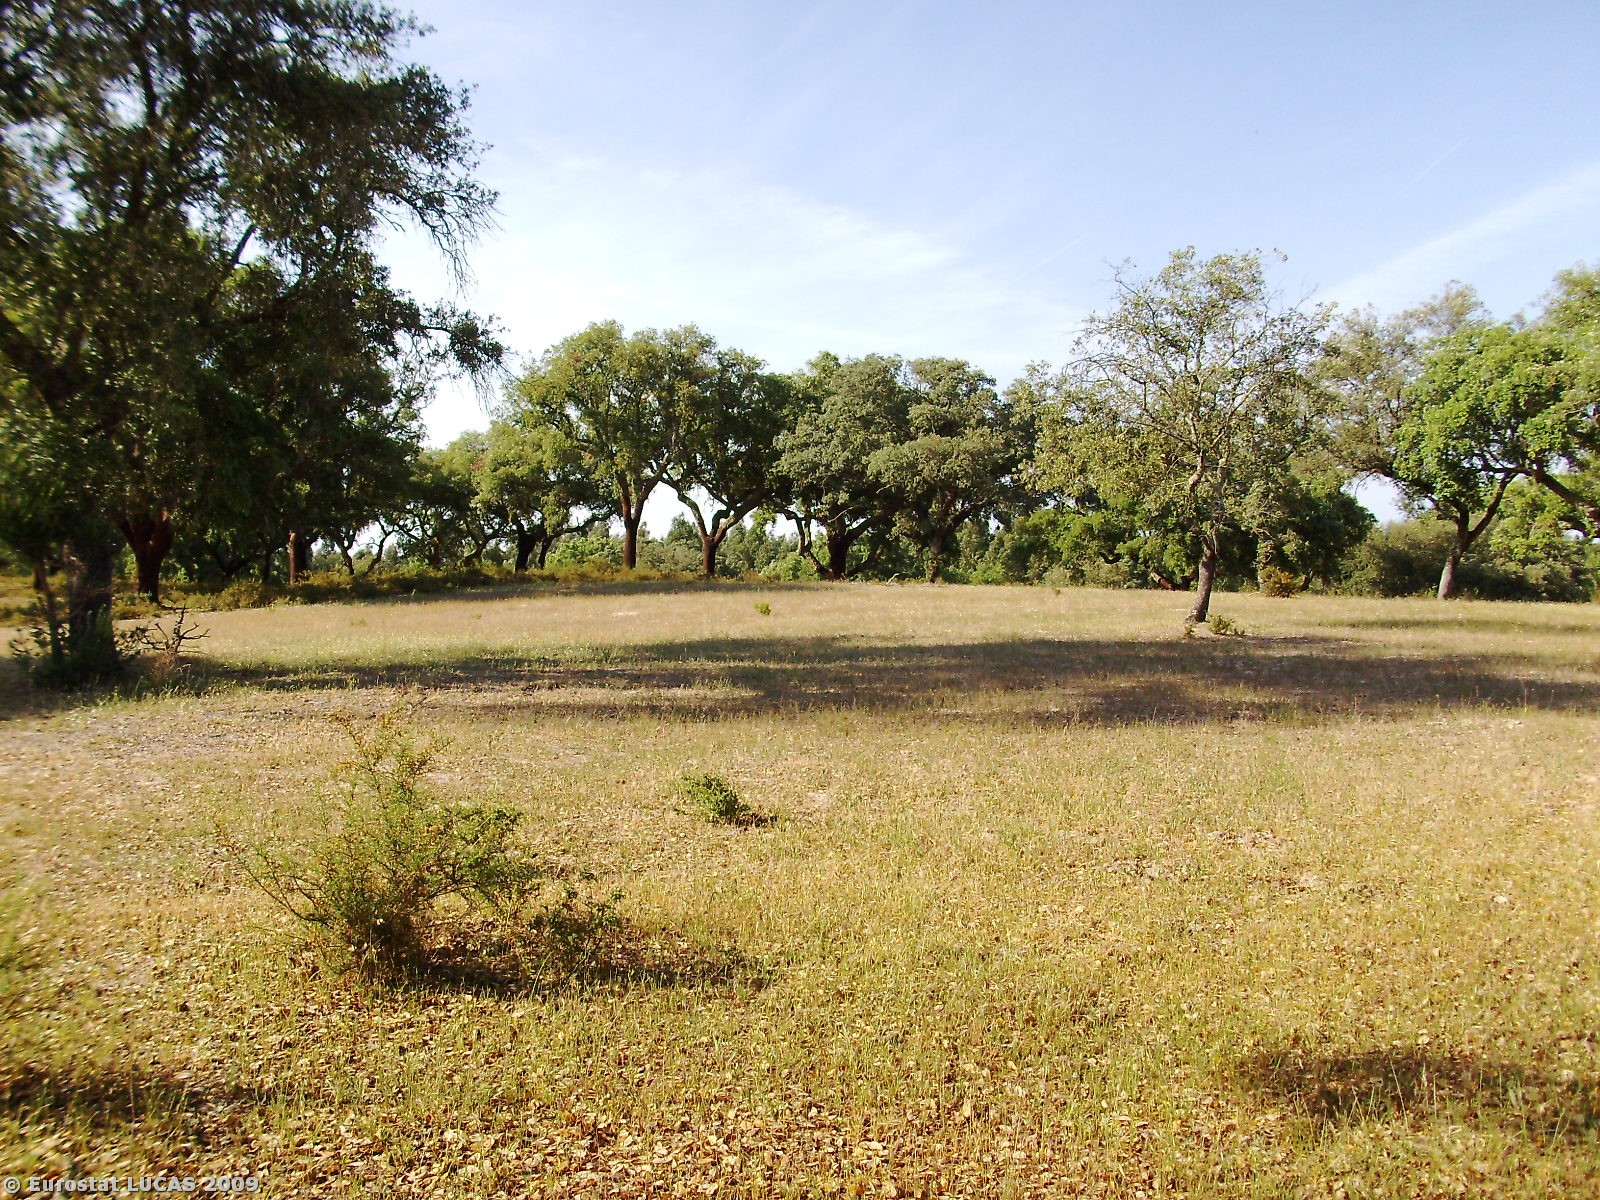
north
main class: Woodland
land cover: Broadleaved woodland
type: broadleaved evergreen forest
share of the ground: 50 - 75 %
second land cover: Grassland with sparse tree/shrub cover
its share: 25 - 50 %
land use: Forestry
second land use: Agriculture (excluding fallow land and kitchen gardens)
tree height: > 5 m
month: May
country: PT
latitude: 39.0324
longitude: -7.9905
